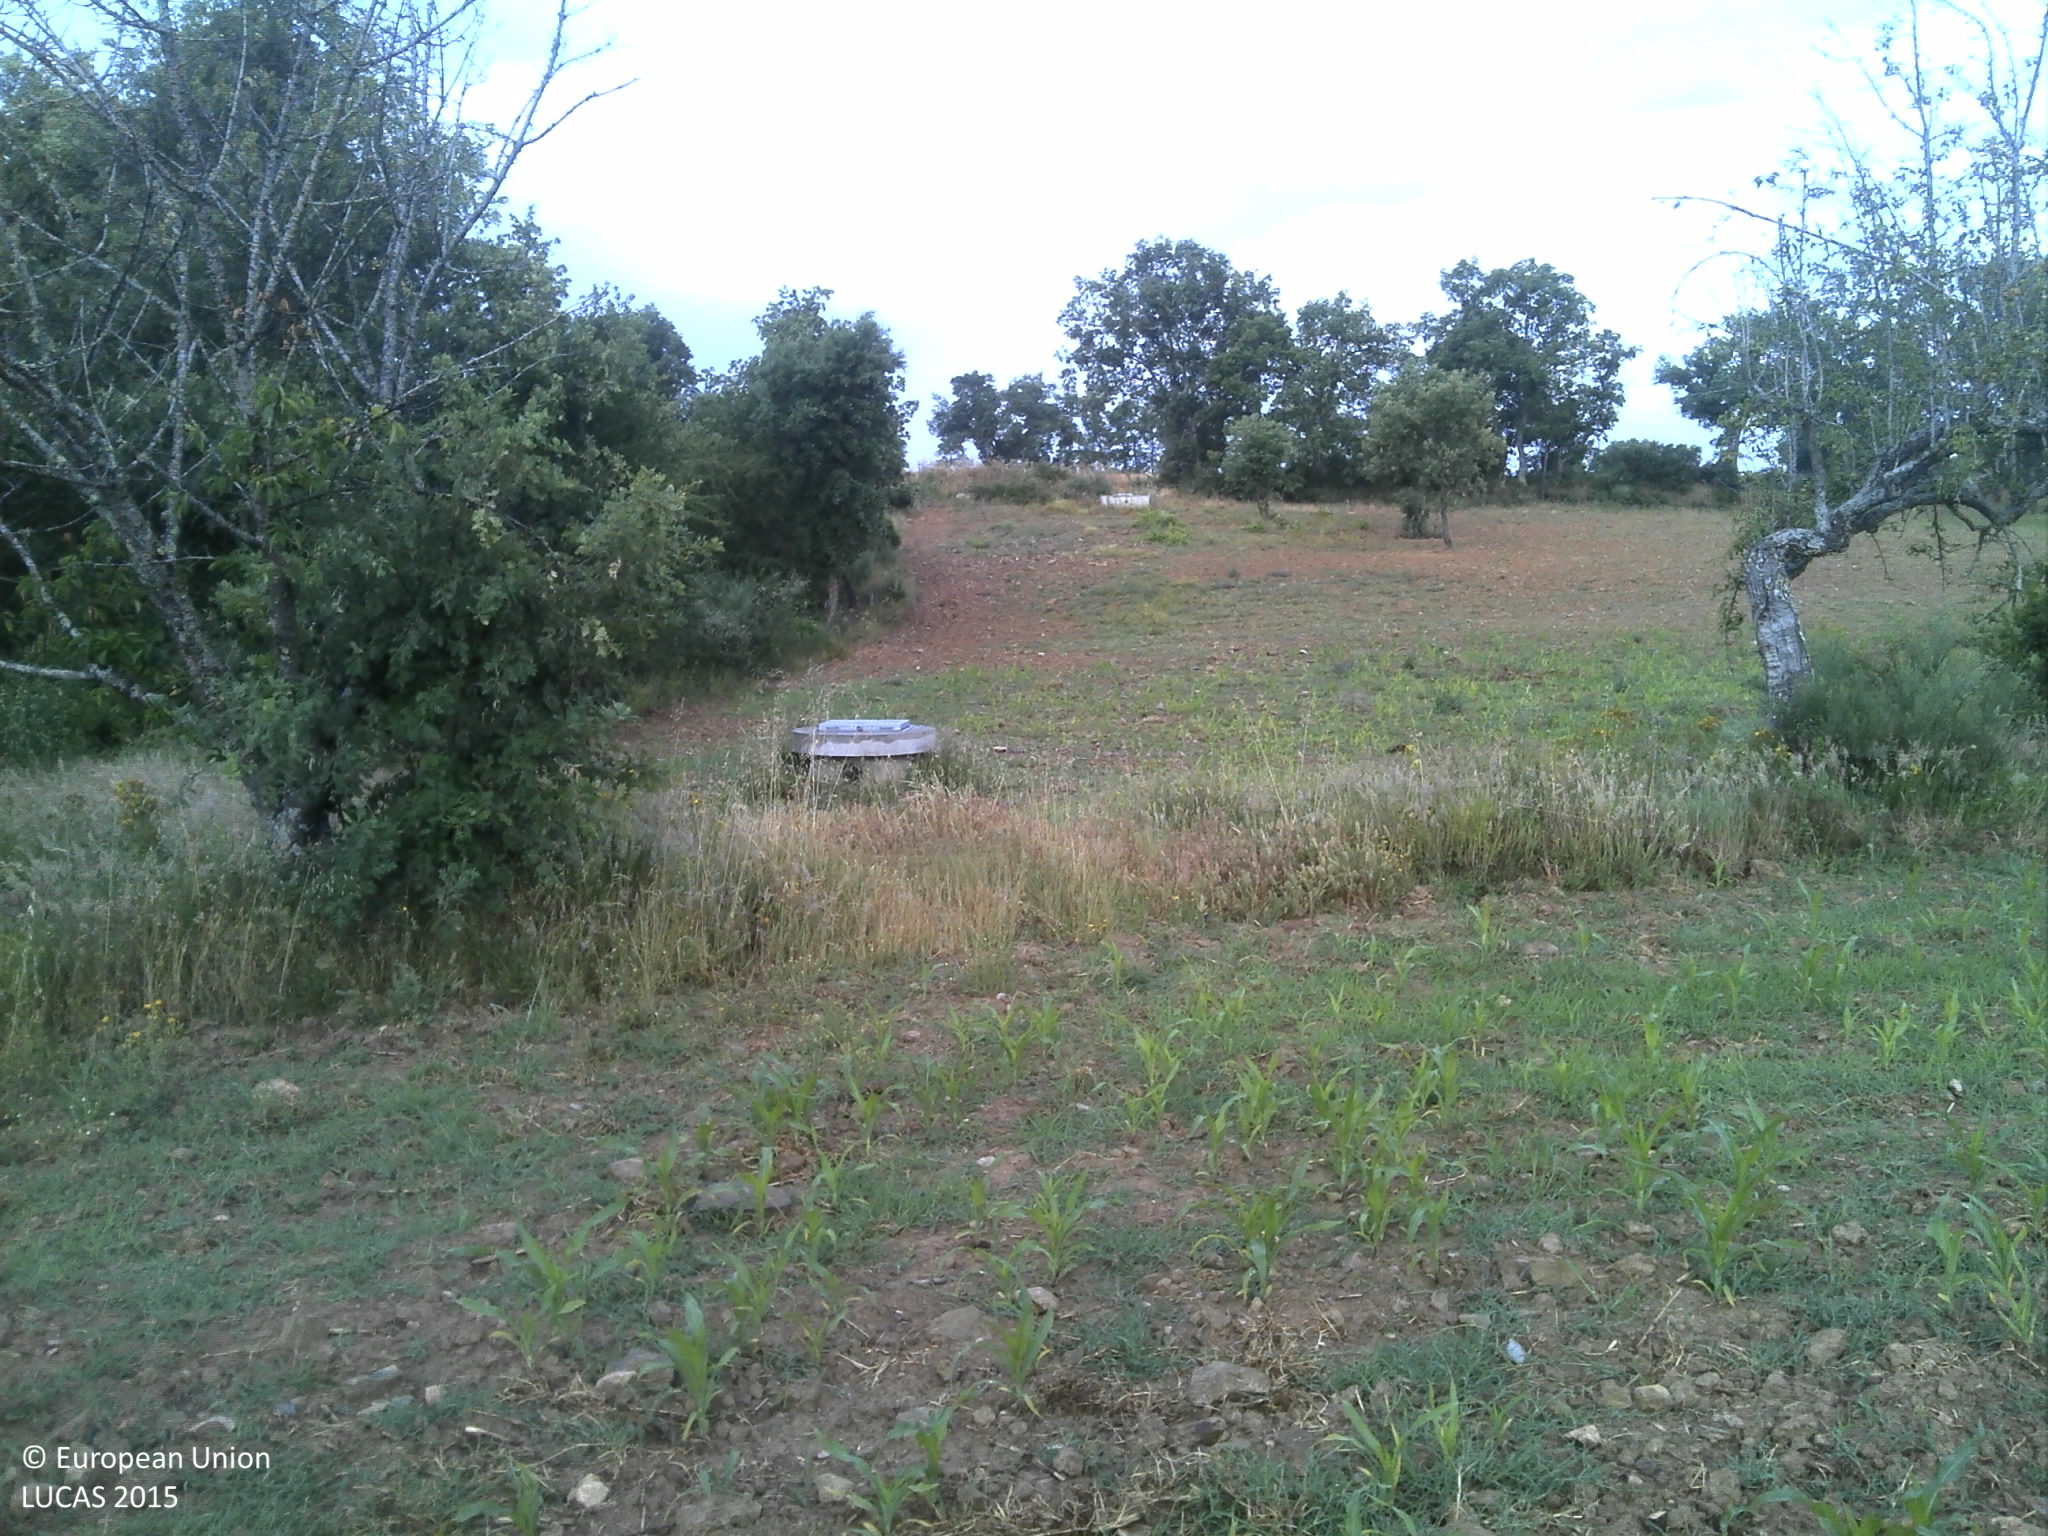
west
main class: Cropland
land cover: Maize
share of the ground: 10 - 25 %
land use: Agriculture (excluding fallow land and kitchen gardens)
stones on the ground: 10 - 25 %
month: June
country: PT
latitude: 40.1927
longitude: -7.4058
